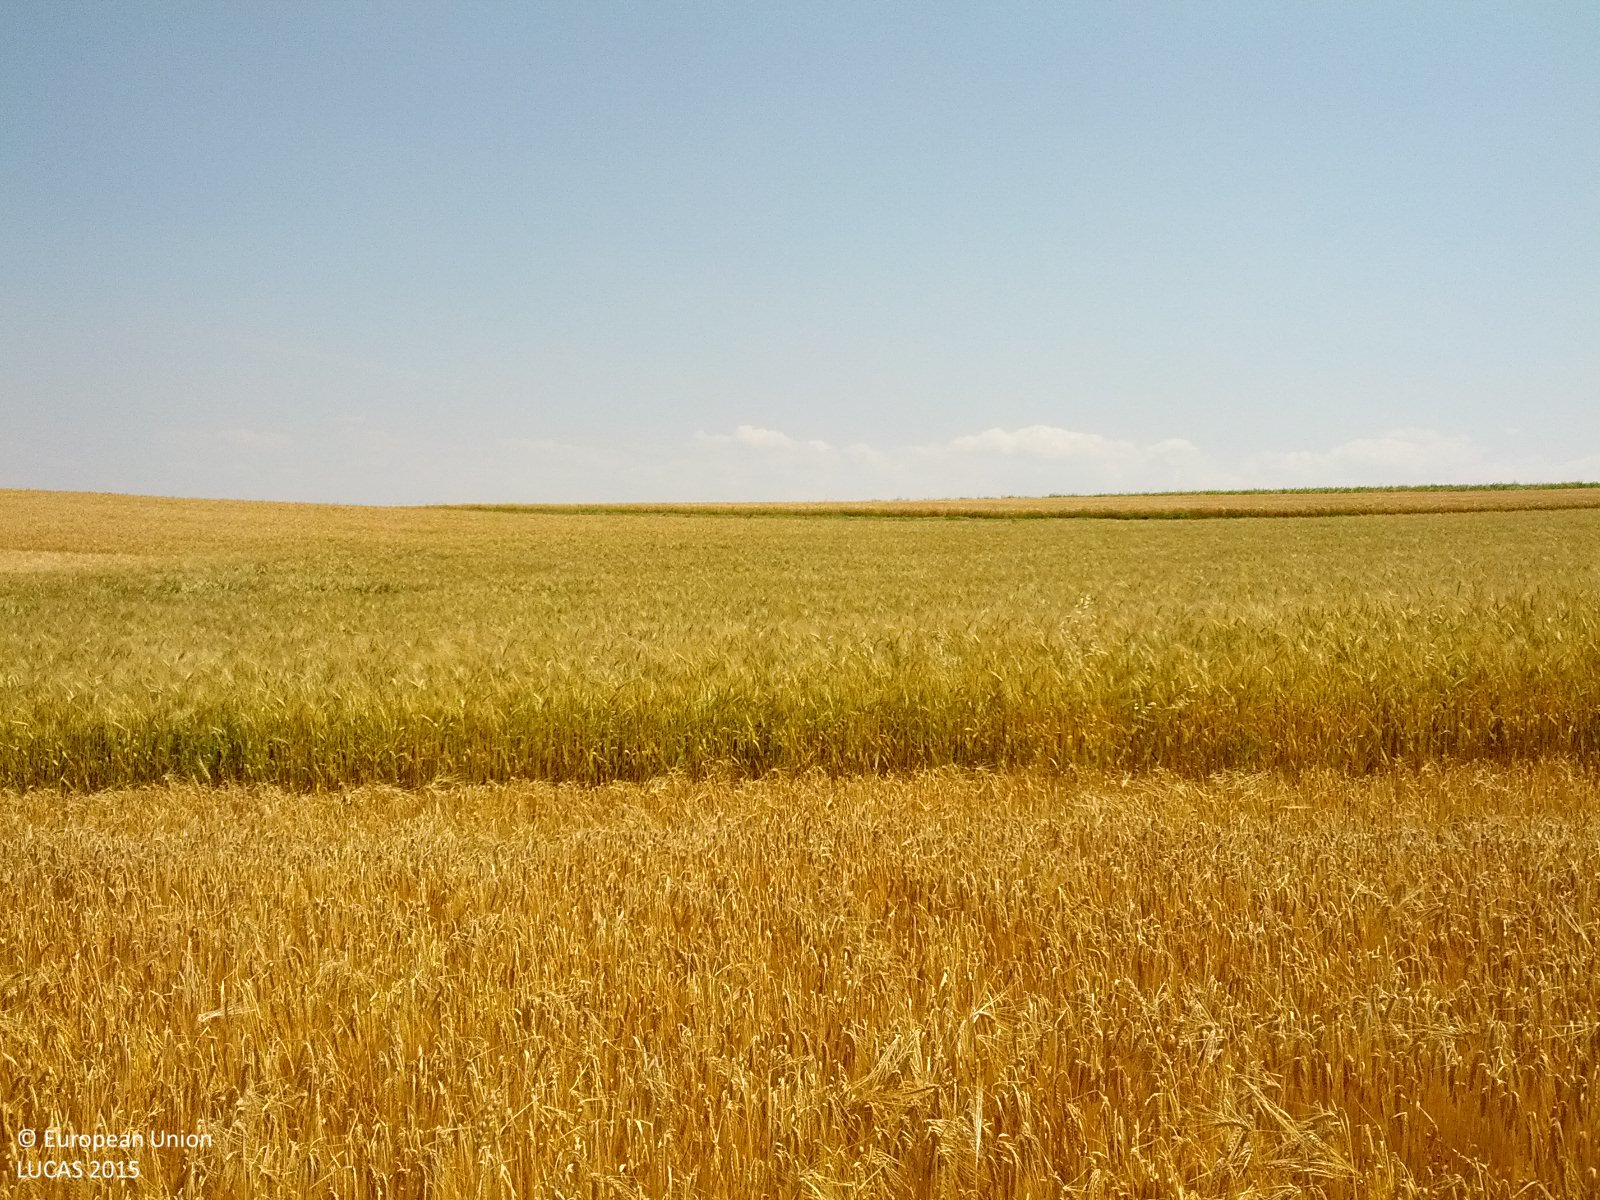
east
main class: Cropland
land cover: Barley
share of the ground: > 75 %
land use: Agriculture (excluding fallow land and kitchen gardens)
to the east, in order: Barley; Common wheat; Barley; Grassland without tree/shrub cover; Barley; Other fibre and oleaginous crops; Abandoned hedges; Barley; Grassland without tree/shrub cover; Common wheat; Spontaneously vegetated surfaces; Common wheat
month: July
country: AT
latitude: 48.5409
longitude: 16.7387
